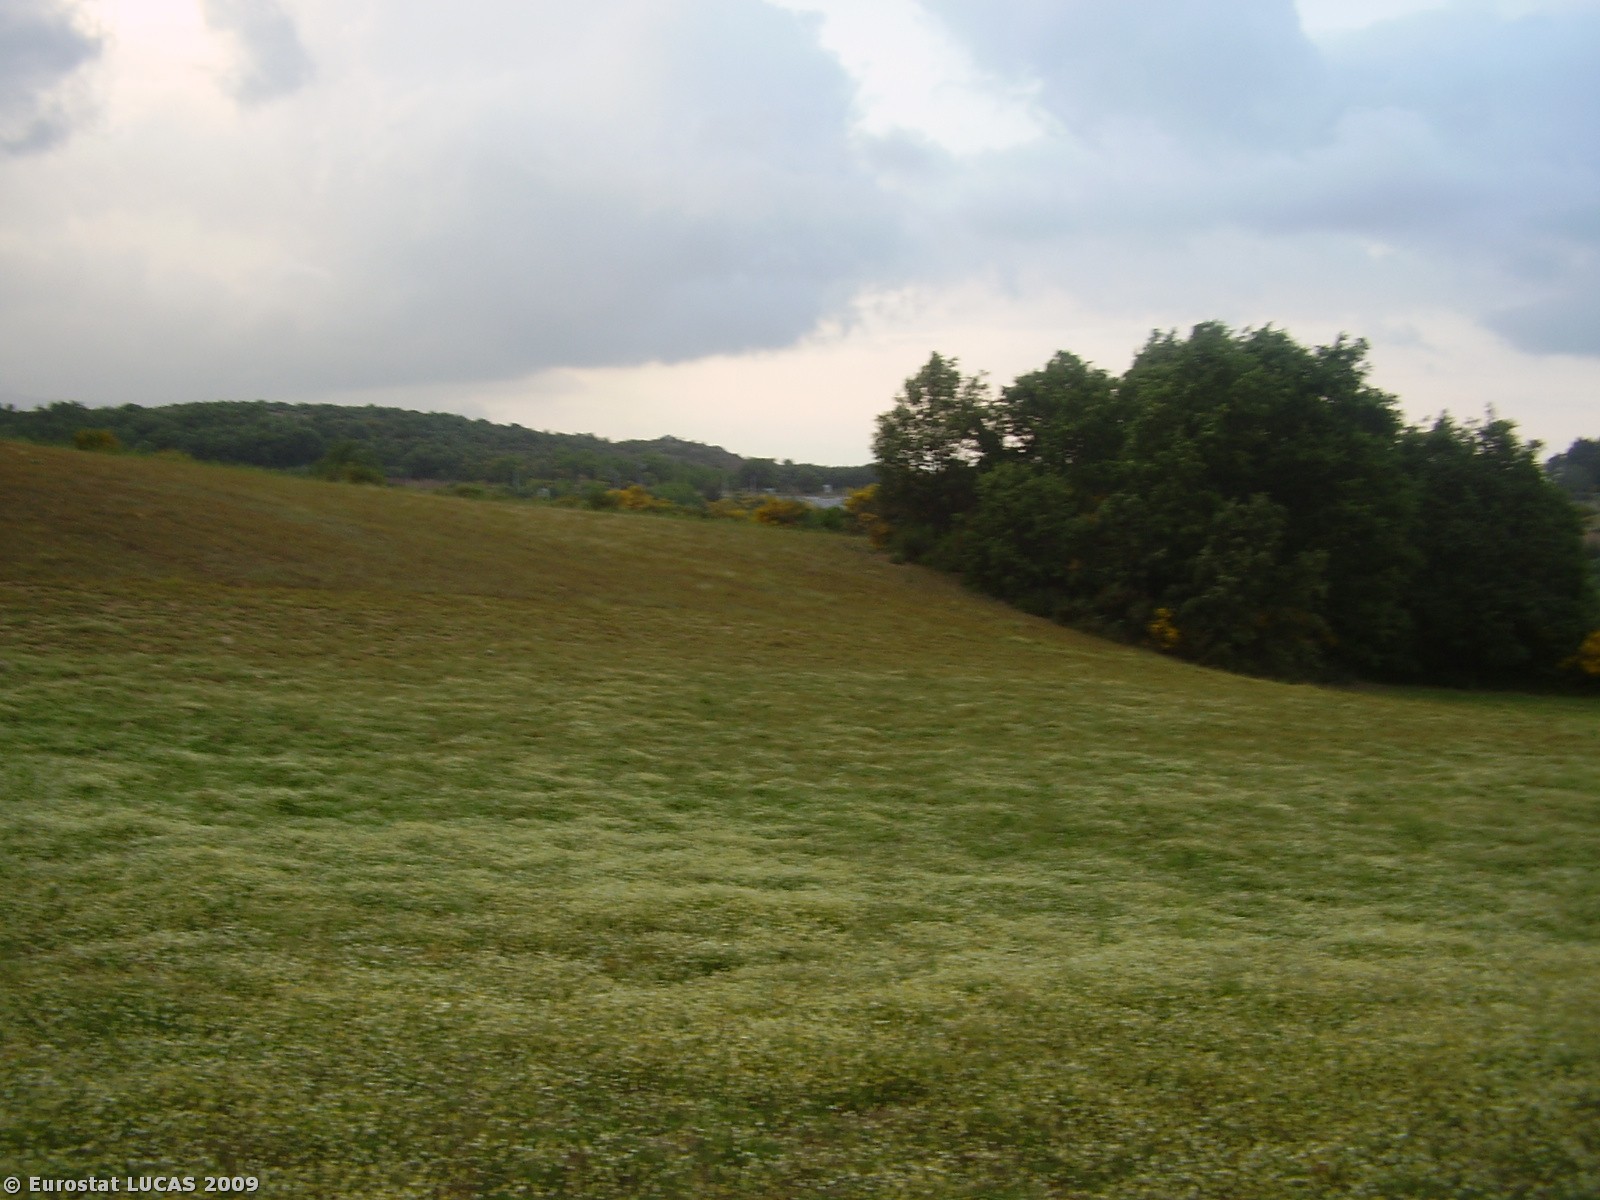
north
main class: Grassland
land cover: Grassland without tree/shrub cover
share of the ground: > 75 %
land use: Forestry
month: June
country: PT
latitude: 41.6595
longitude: -6.8170
